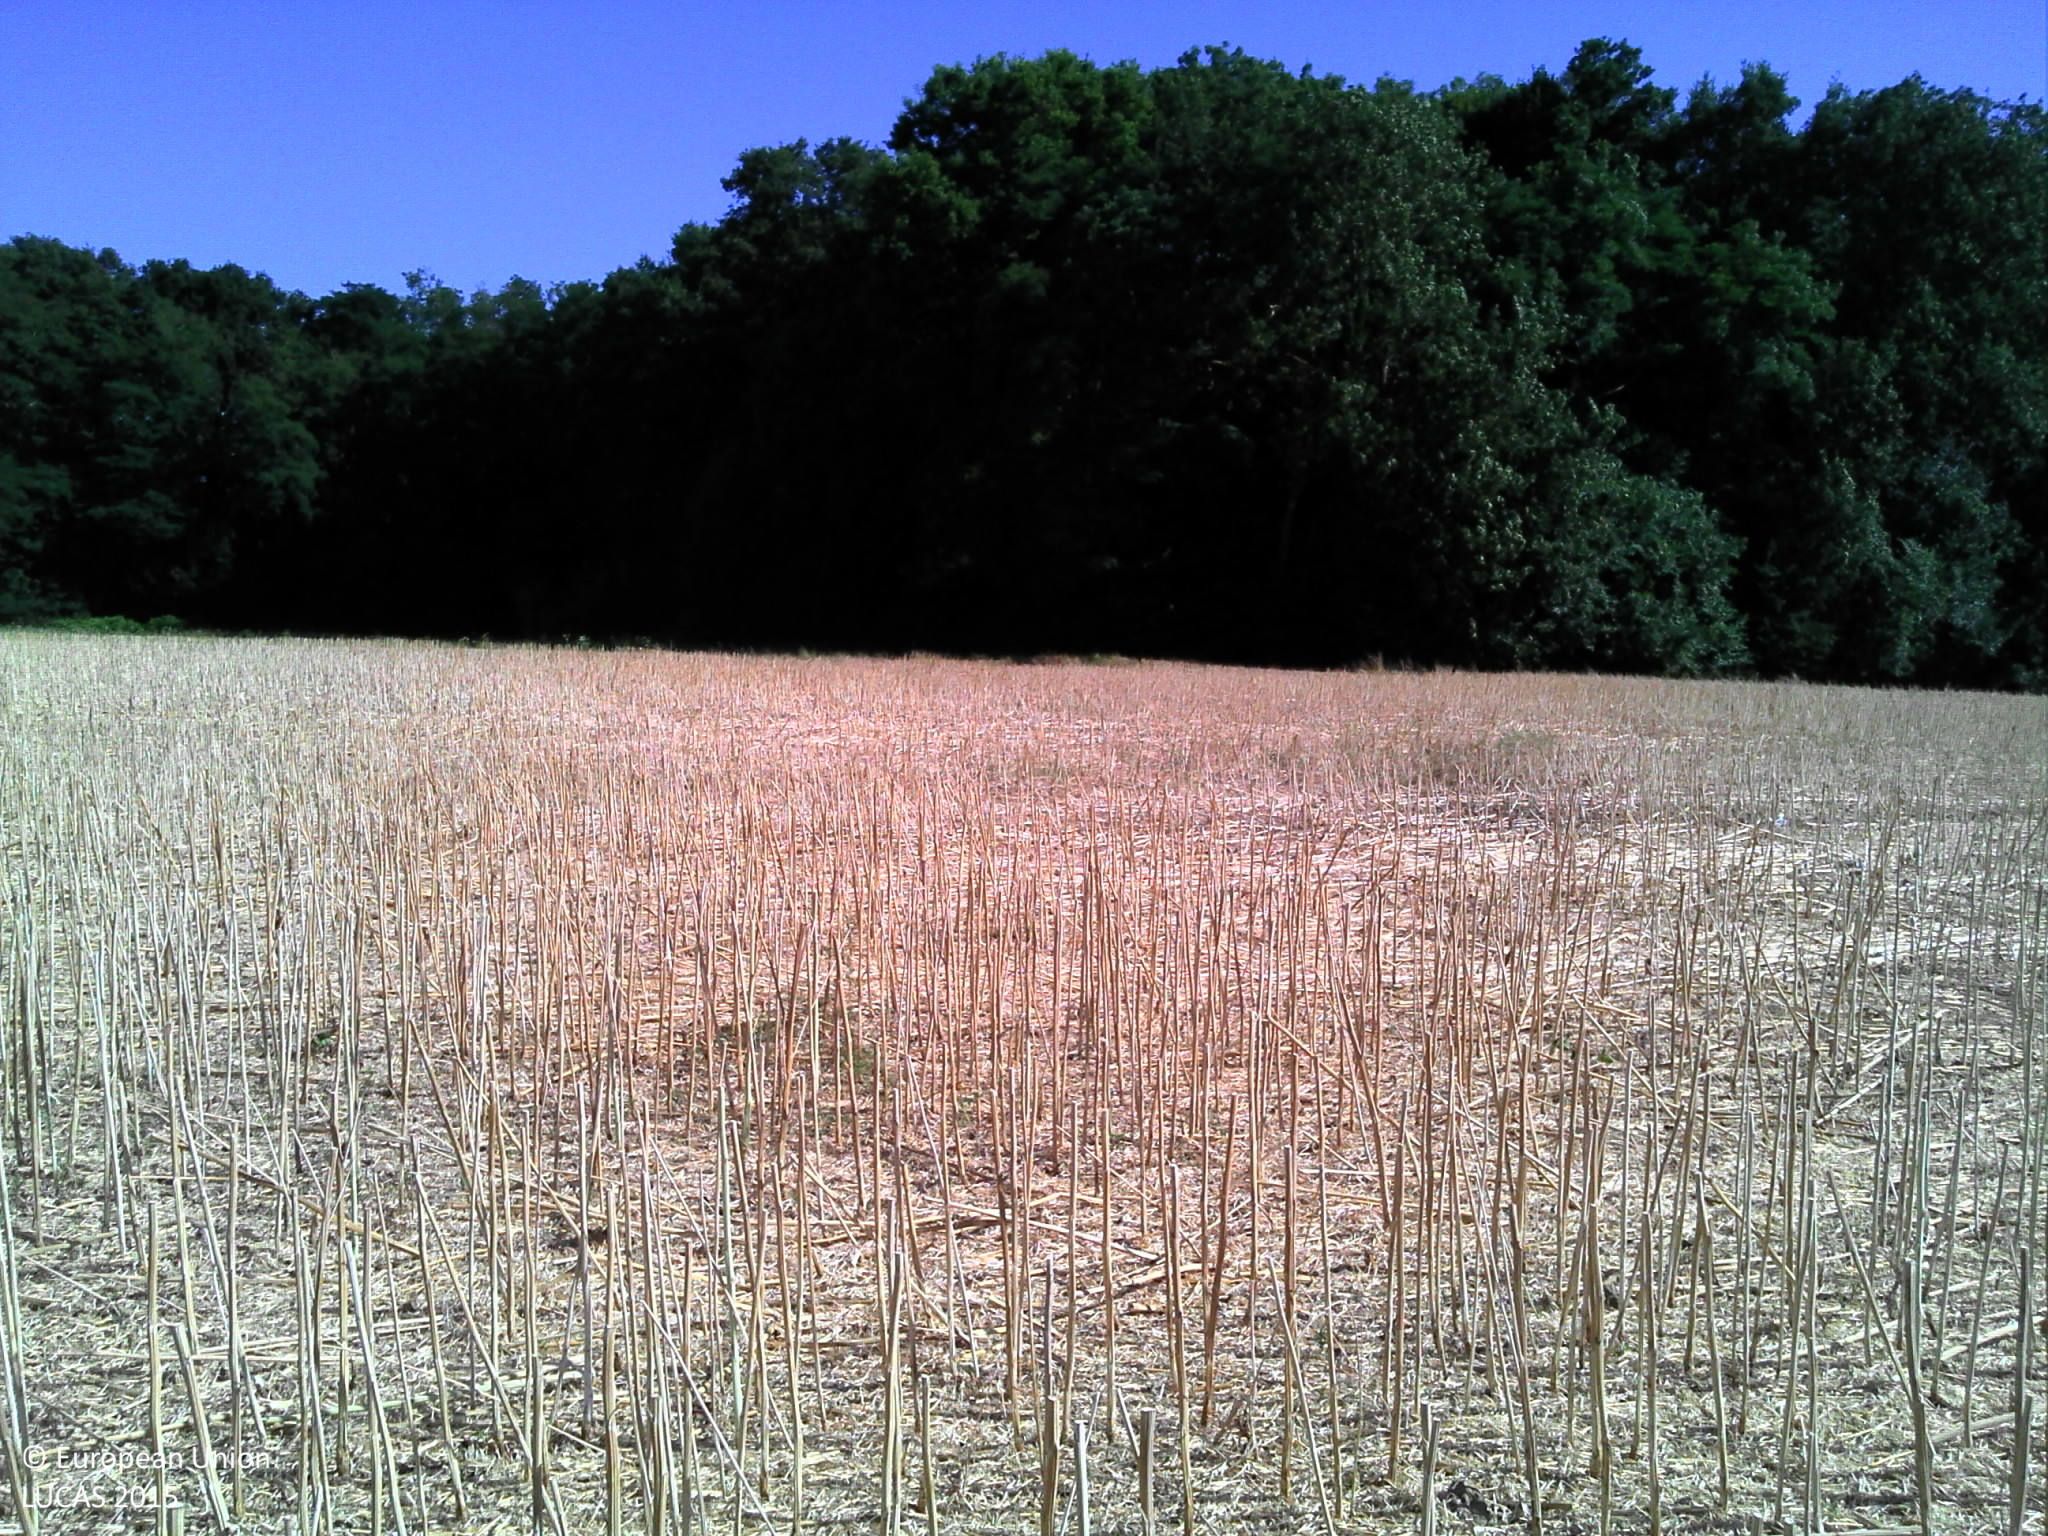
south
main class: Cropland
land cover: Rape and turnip rape
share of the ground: > 75 %
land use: Agriculture (excluding fallow land and kitchen gardens)
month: July
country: FR
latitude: 48.1874
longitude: 3.0924
